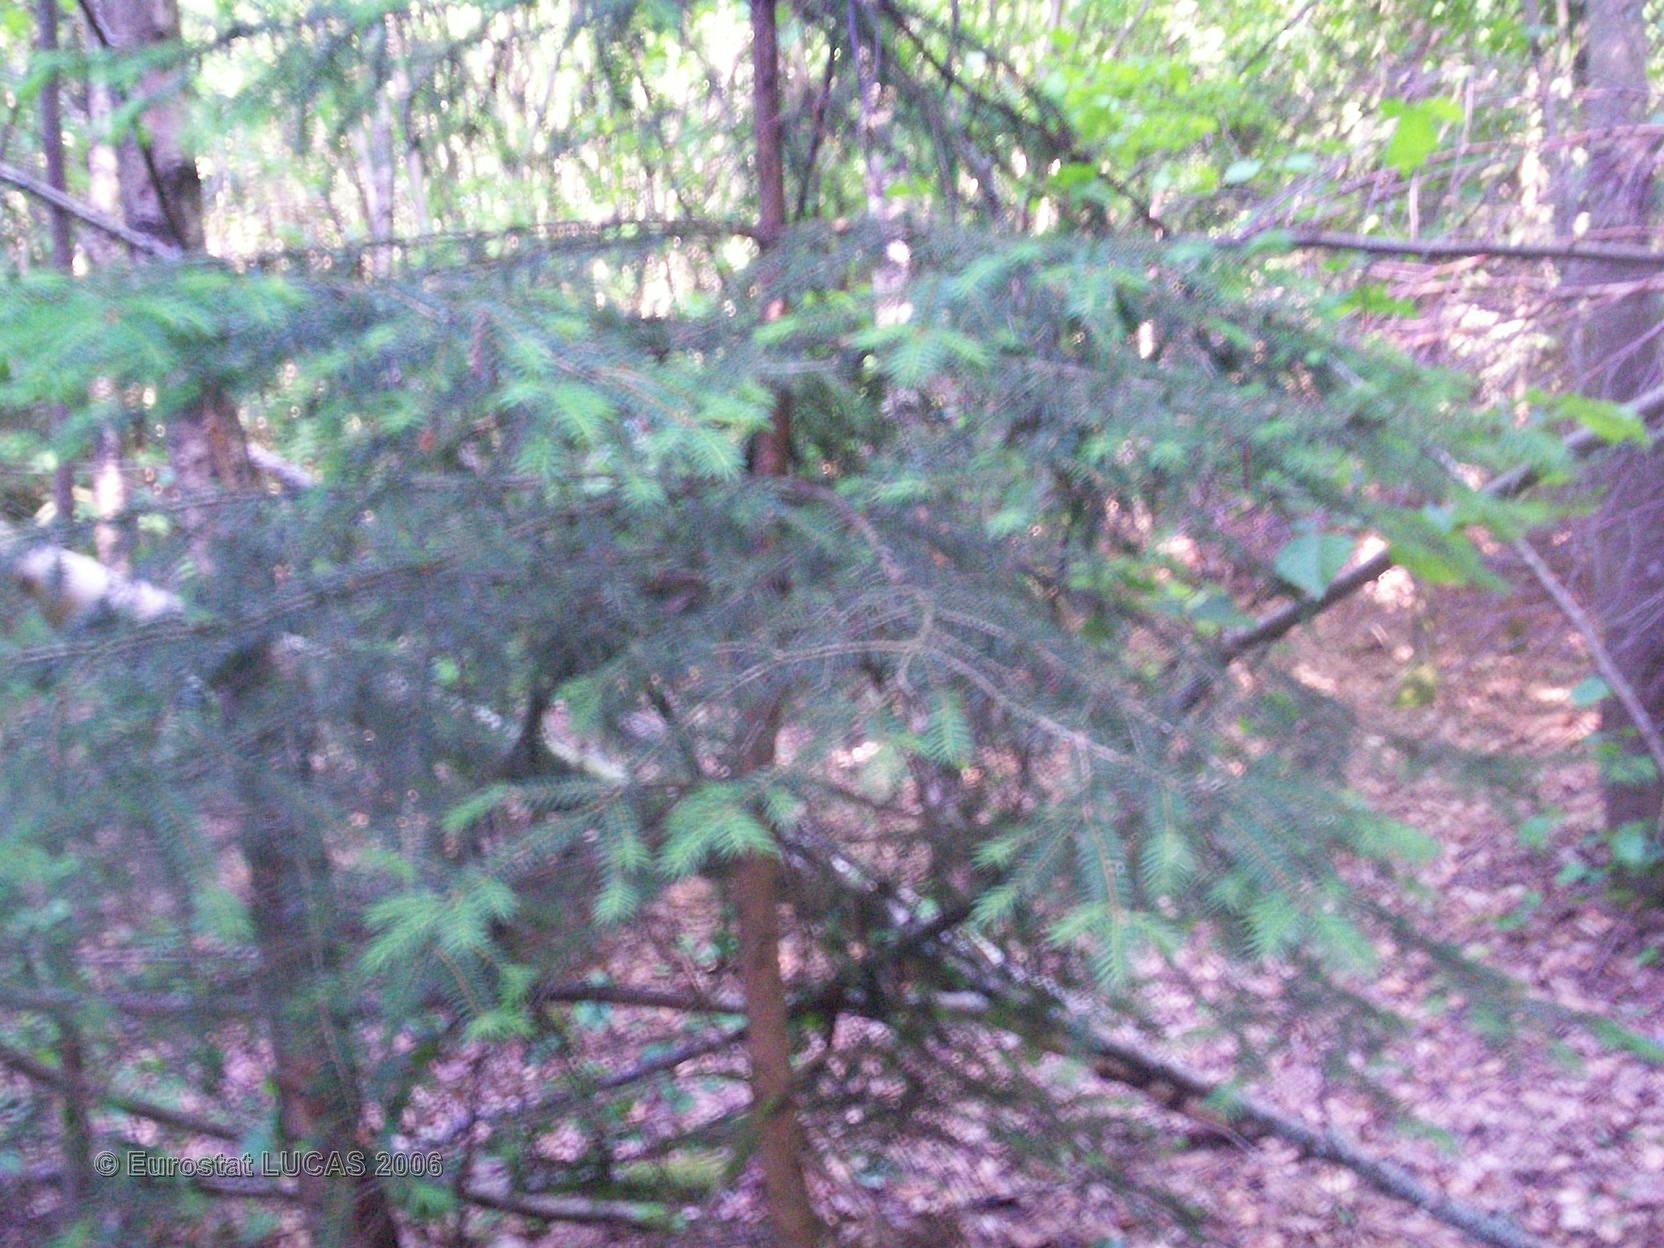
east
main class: Woodland
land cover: Coniferous forest
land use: Forestry
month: June
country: FR
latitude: 48.3274
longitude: 7.0200
